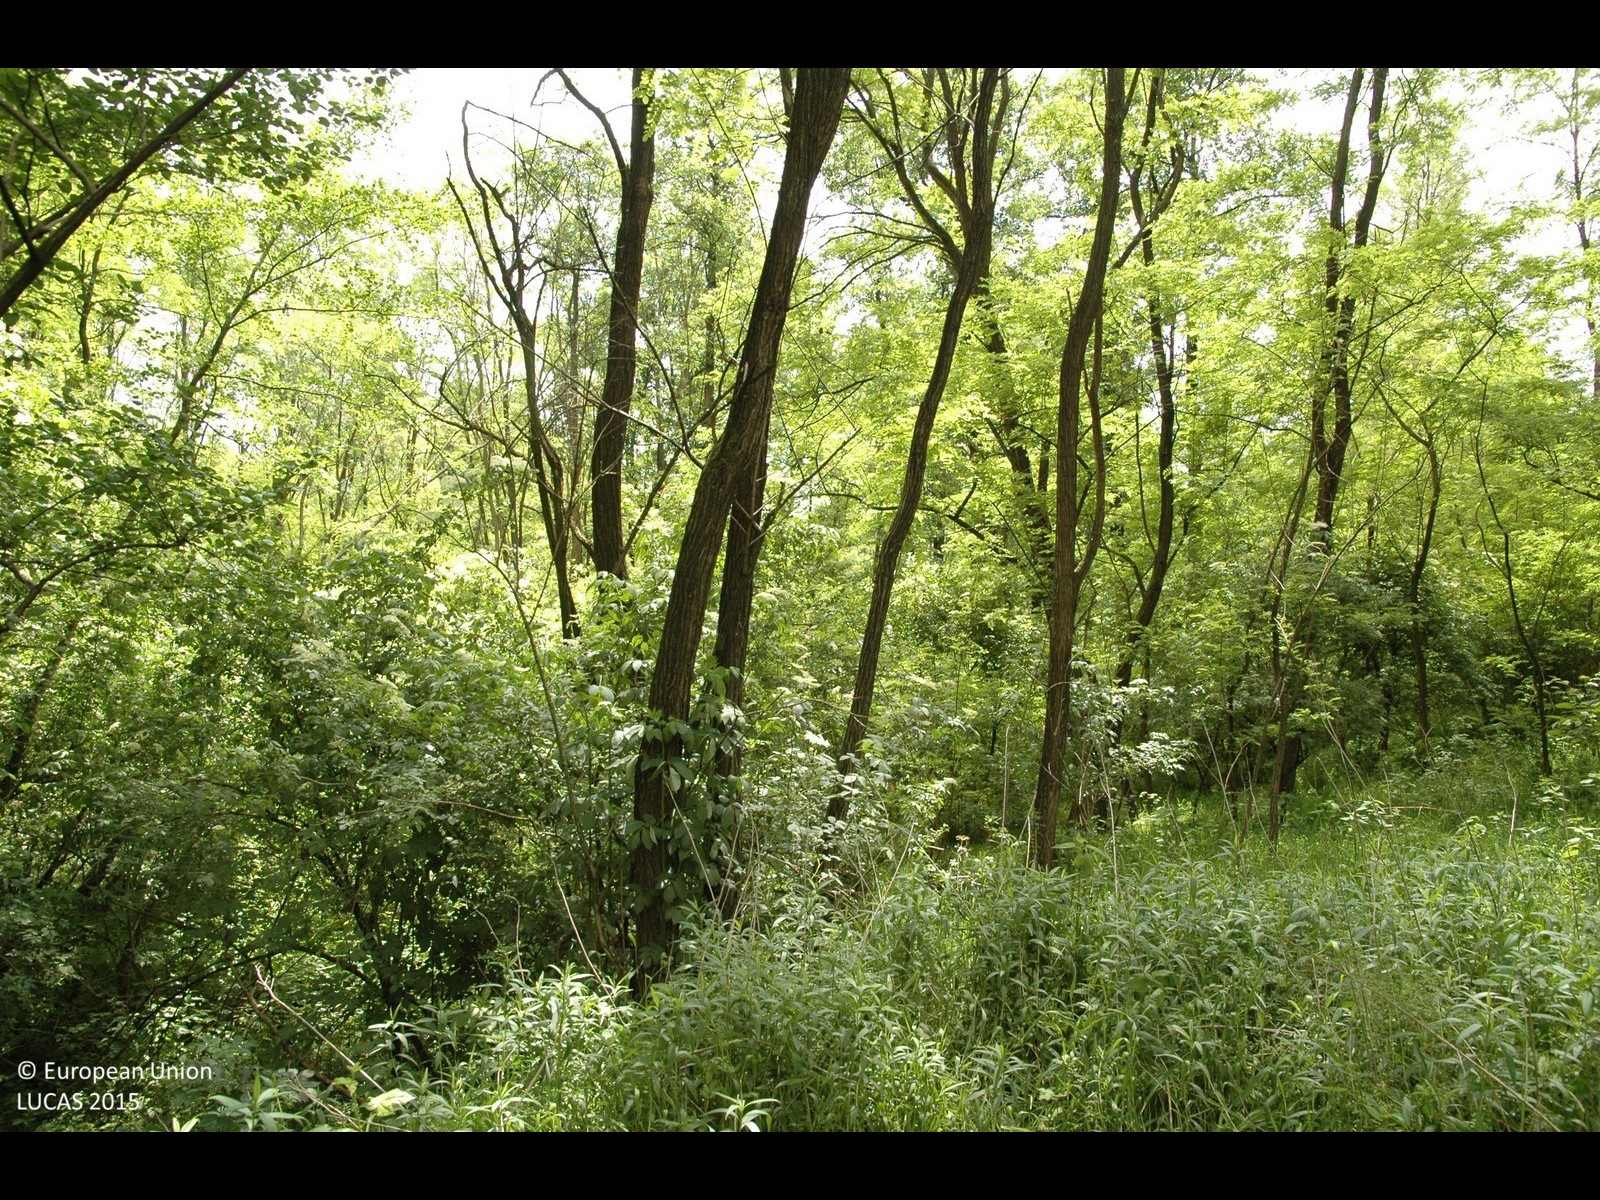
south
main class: Woodland
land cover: Broadleaved woodland
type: mesophytic deciduous forest
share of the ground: > 75 %
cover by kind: broadleaved forest trees 90 %, shrubs 5 %, herbaceous plants 5 %
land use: Forestry
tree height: > 5 m
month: May
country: HR
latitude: 46.4100
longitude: 16.4401
